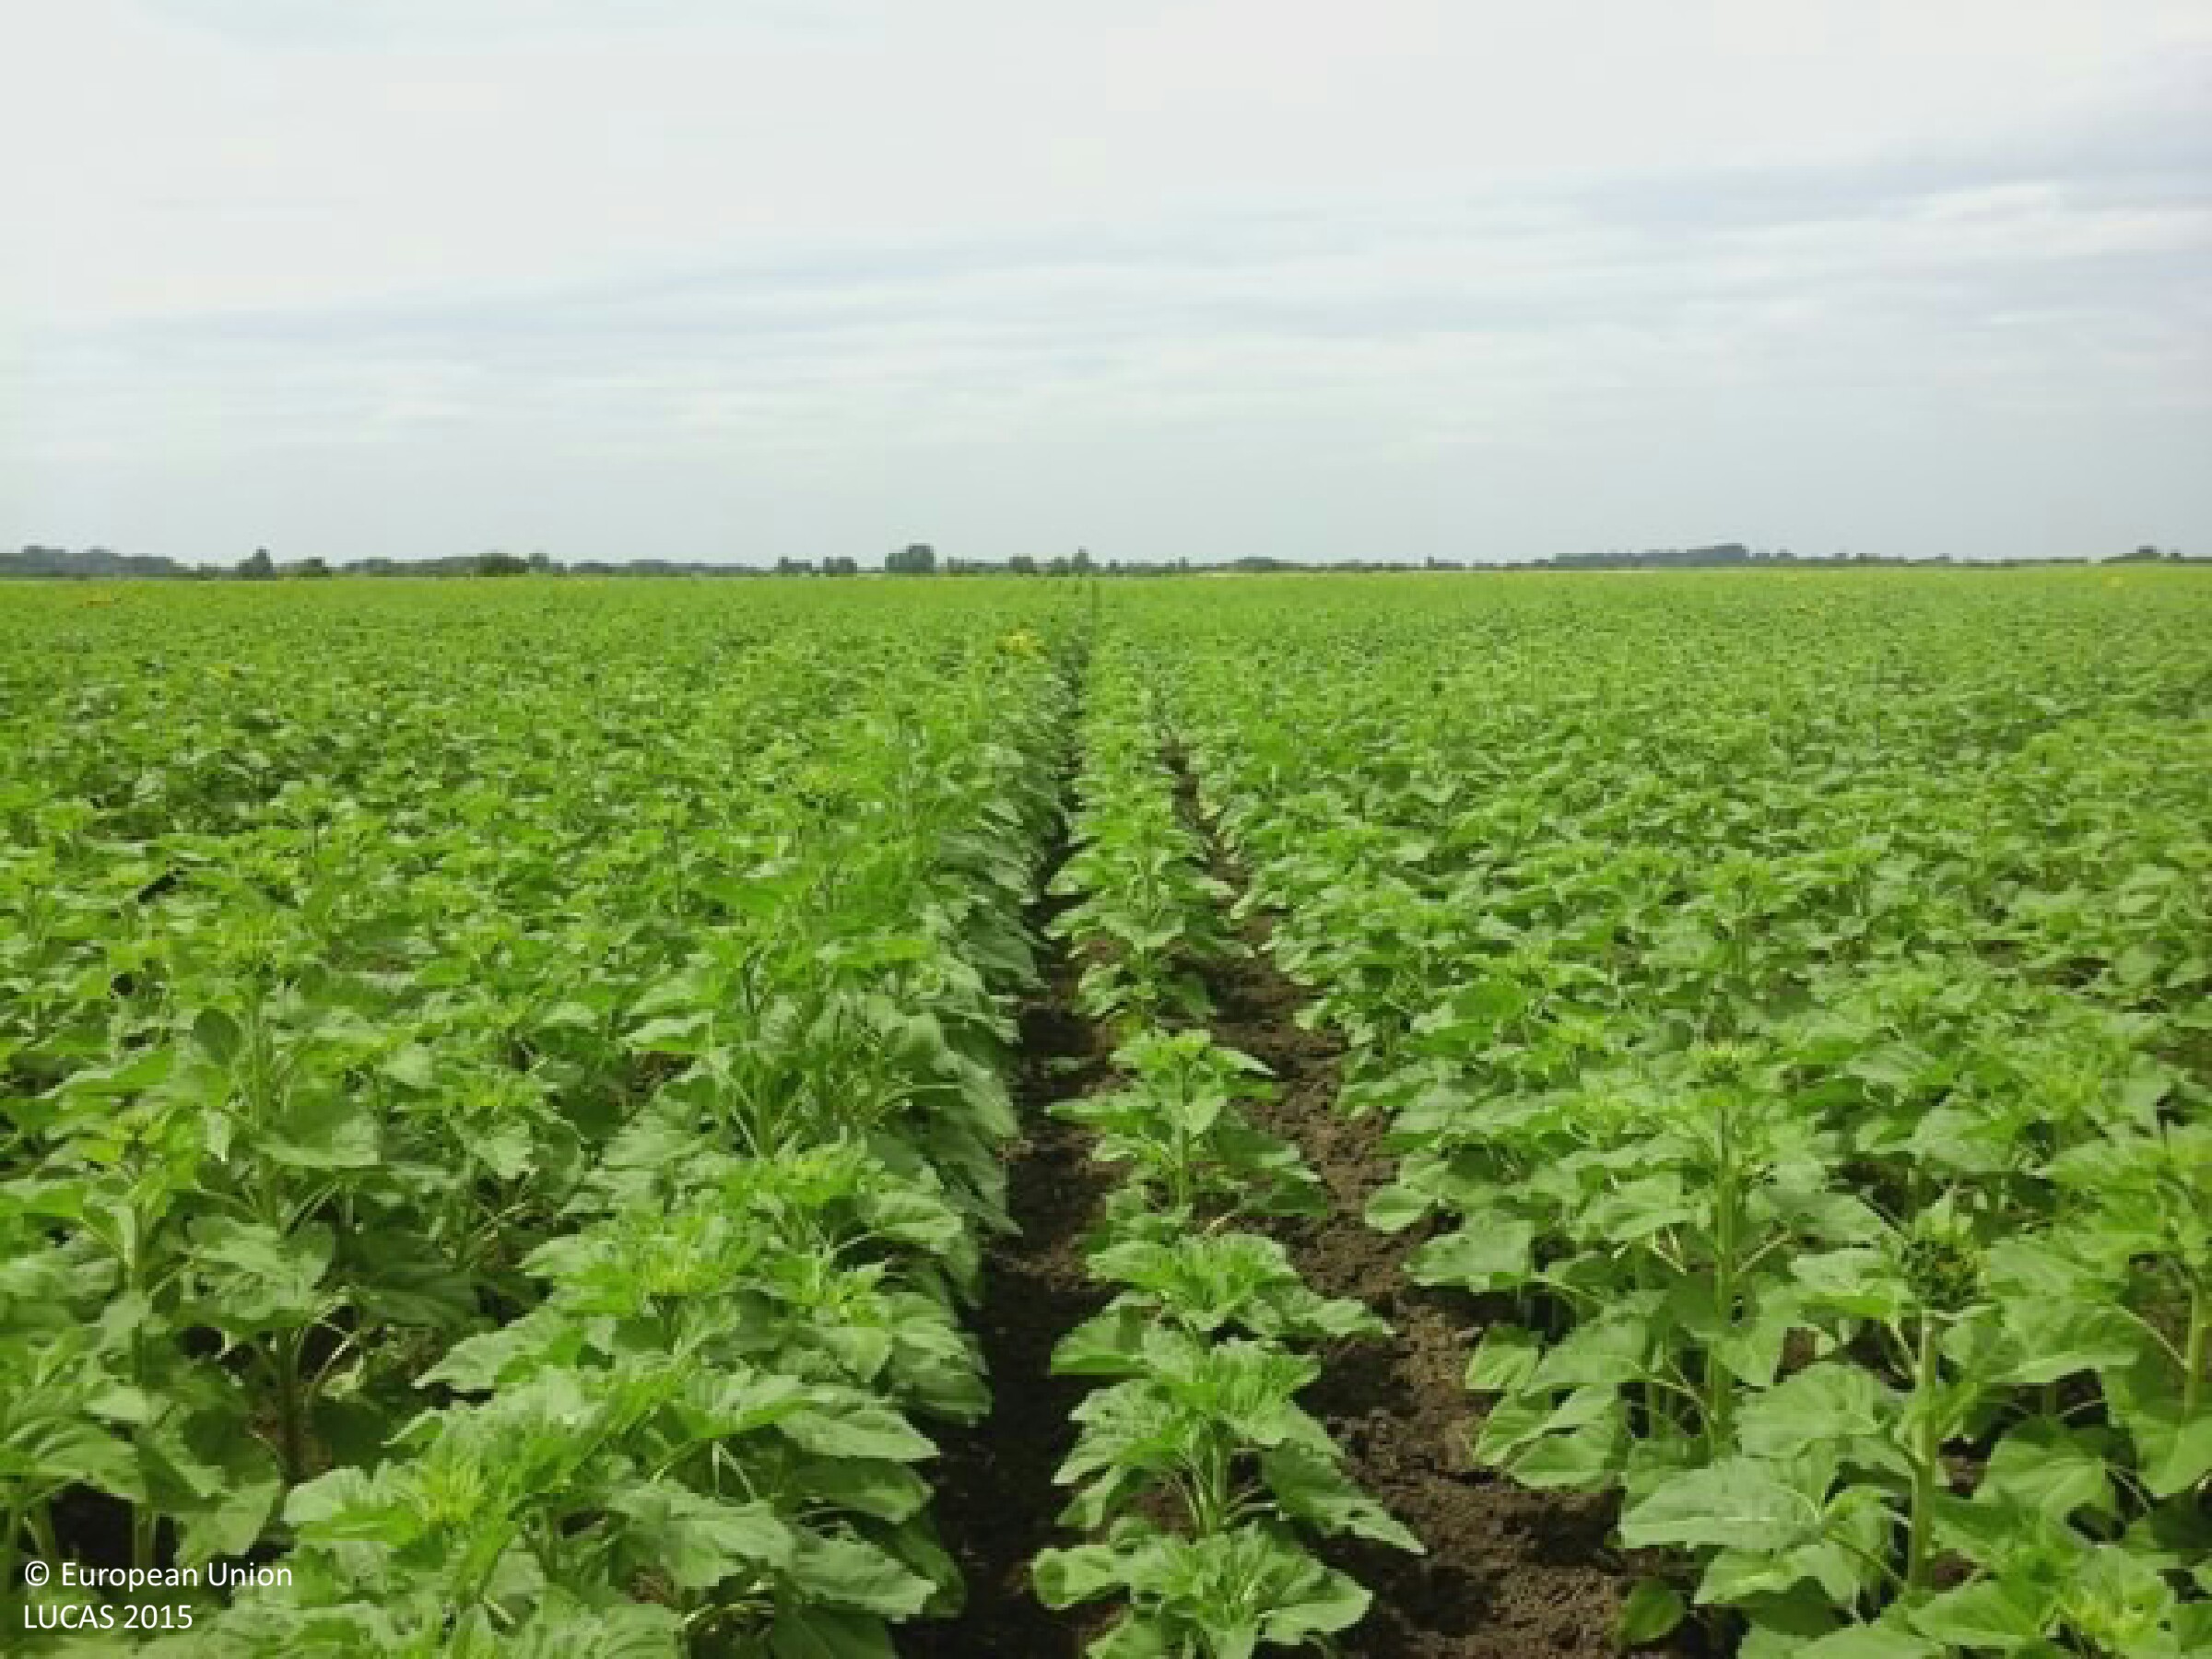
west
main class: Cropland
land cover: Sunflower
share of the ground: > 75 %
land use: Agriculture (excluding fallow land and kitchen gardens)
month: June
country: HU
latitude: 46.6118
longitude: 20.1427
